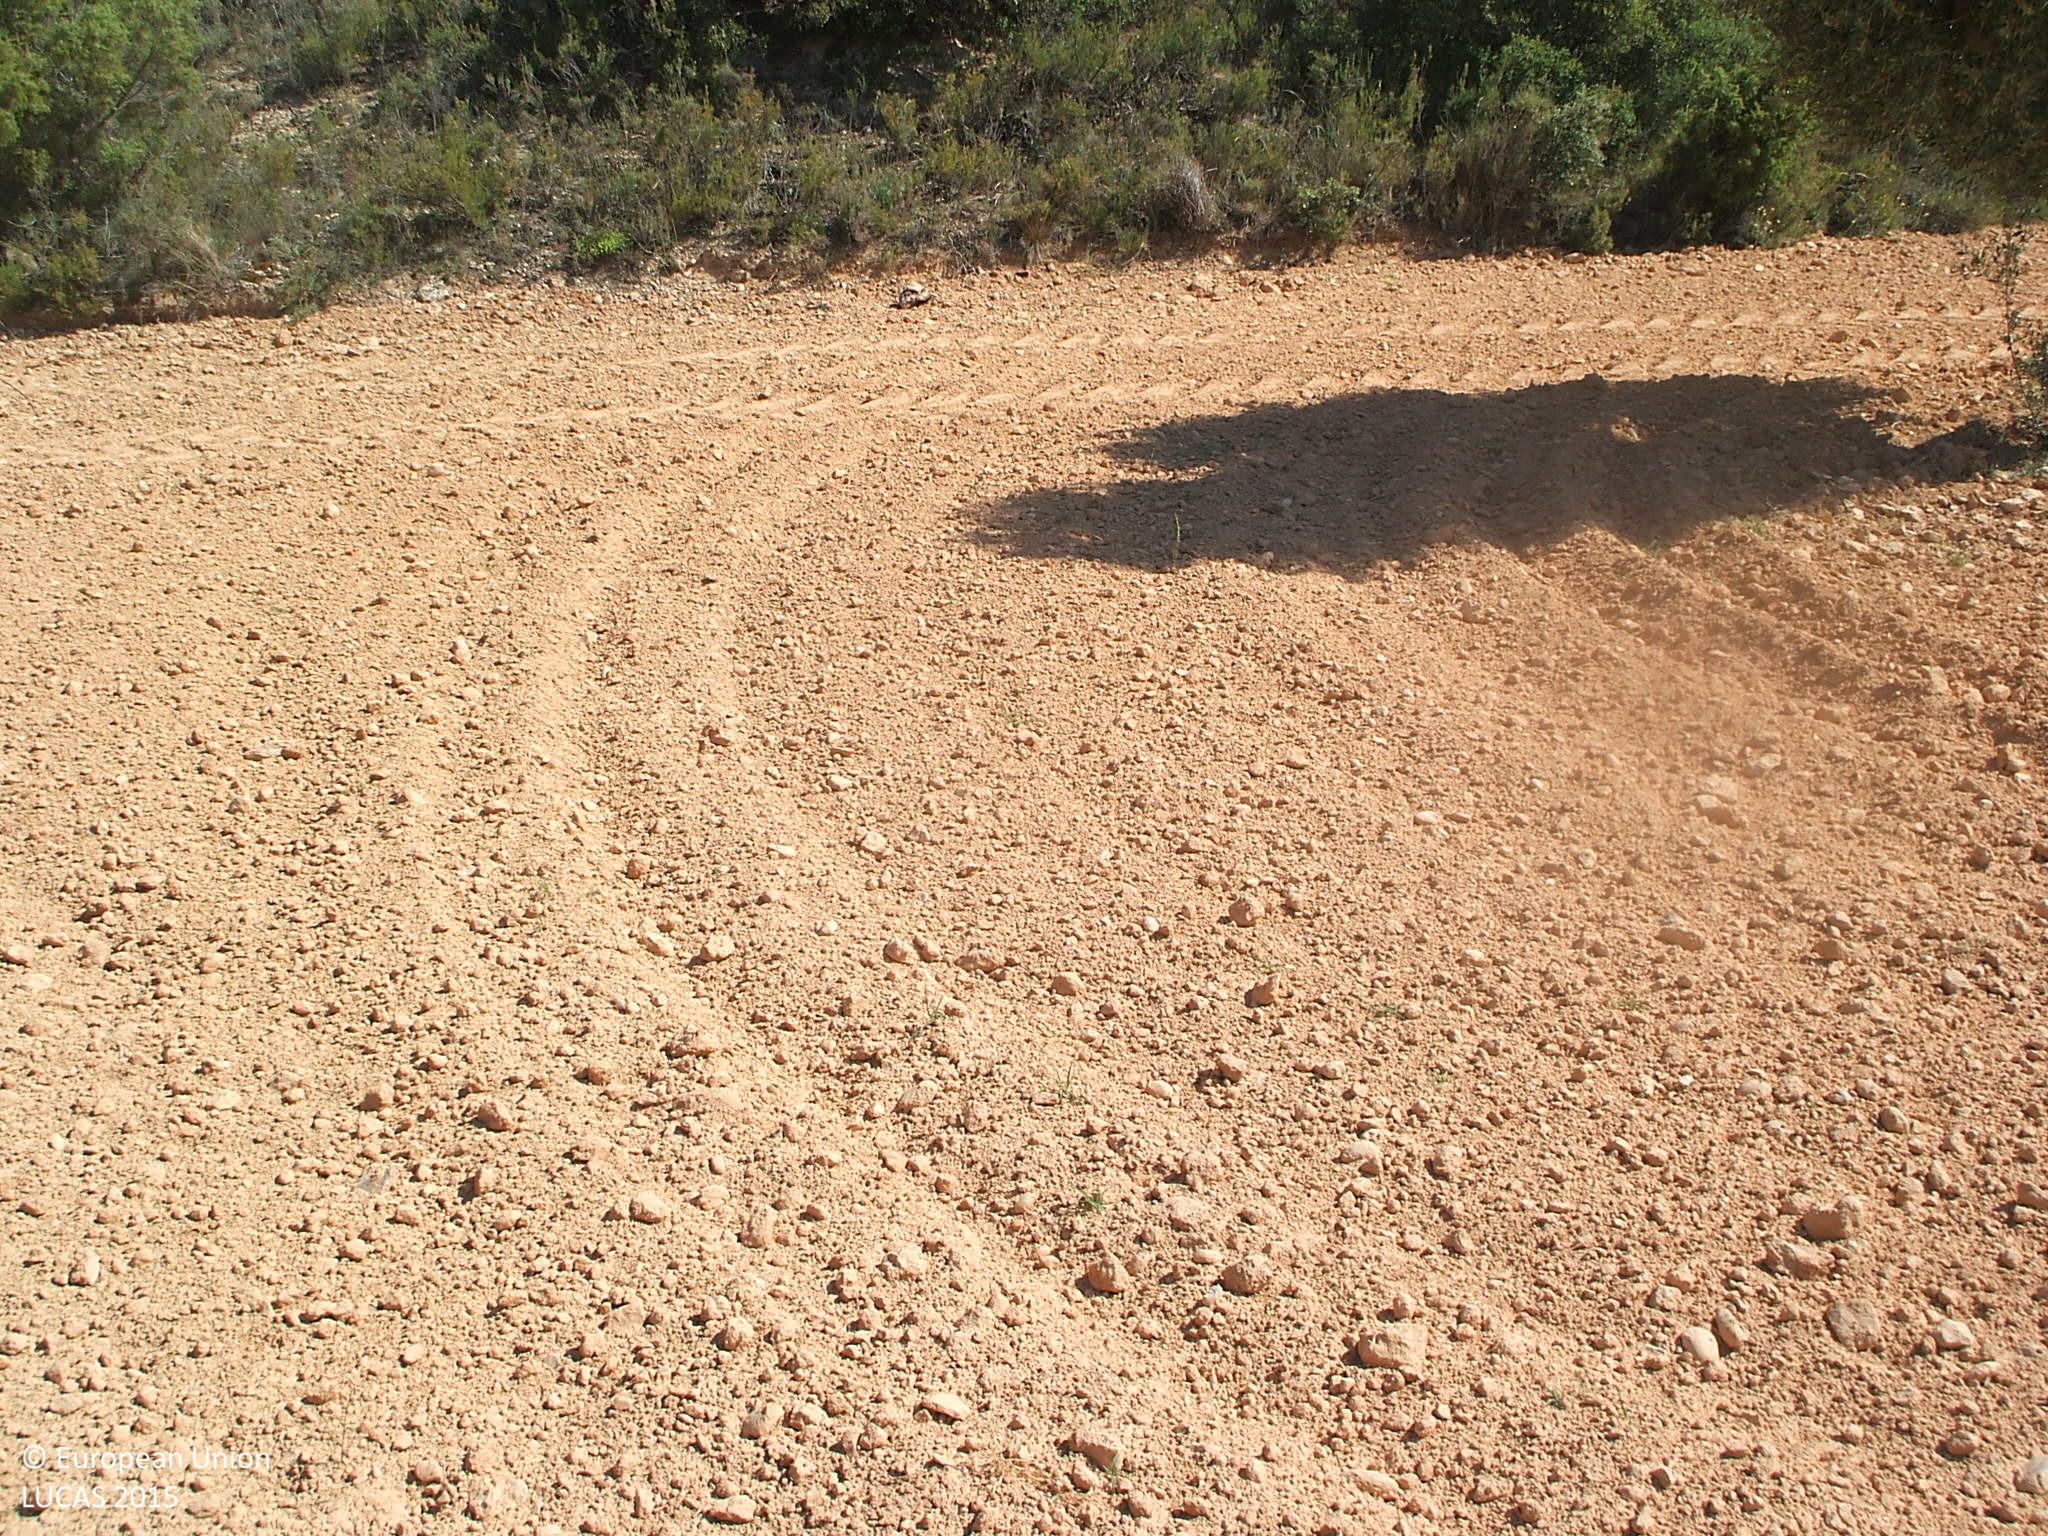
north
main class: Cropland
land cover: Olive groves
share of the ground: 10 - 25 %
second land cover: Other bare soil
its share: > 75 %
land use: Agriculture (excluding fallow land and kitchen gardens)
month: June
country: ES
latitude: 40.9725
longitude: -0.0280
